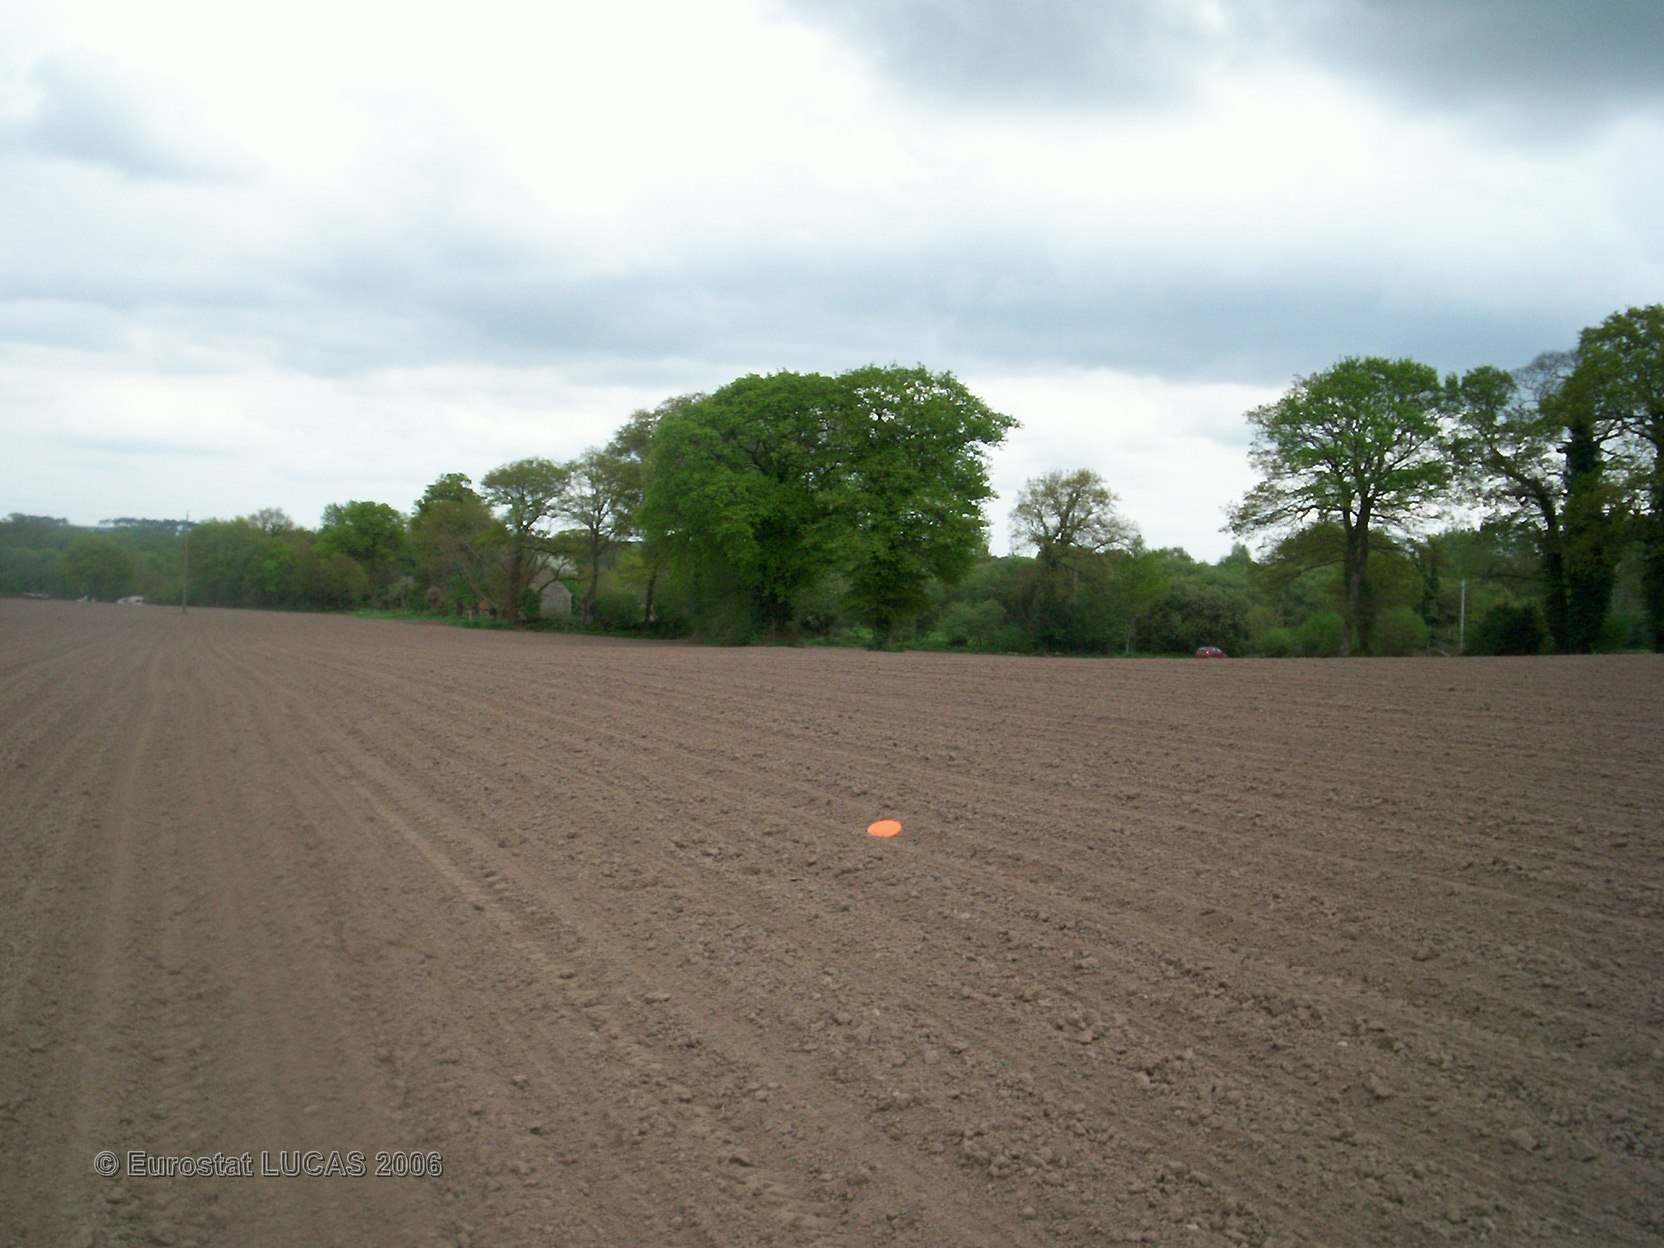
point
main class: Cropland
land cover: Maize
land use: Agriculture (excluding fallow land and kitchen gardens)
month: May
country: FR
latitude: 47.7230
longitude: -2.8487
